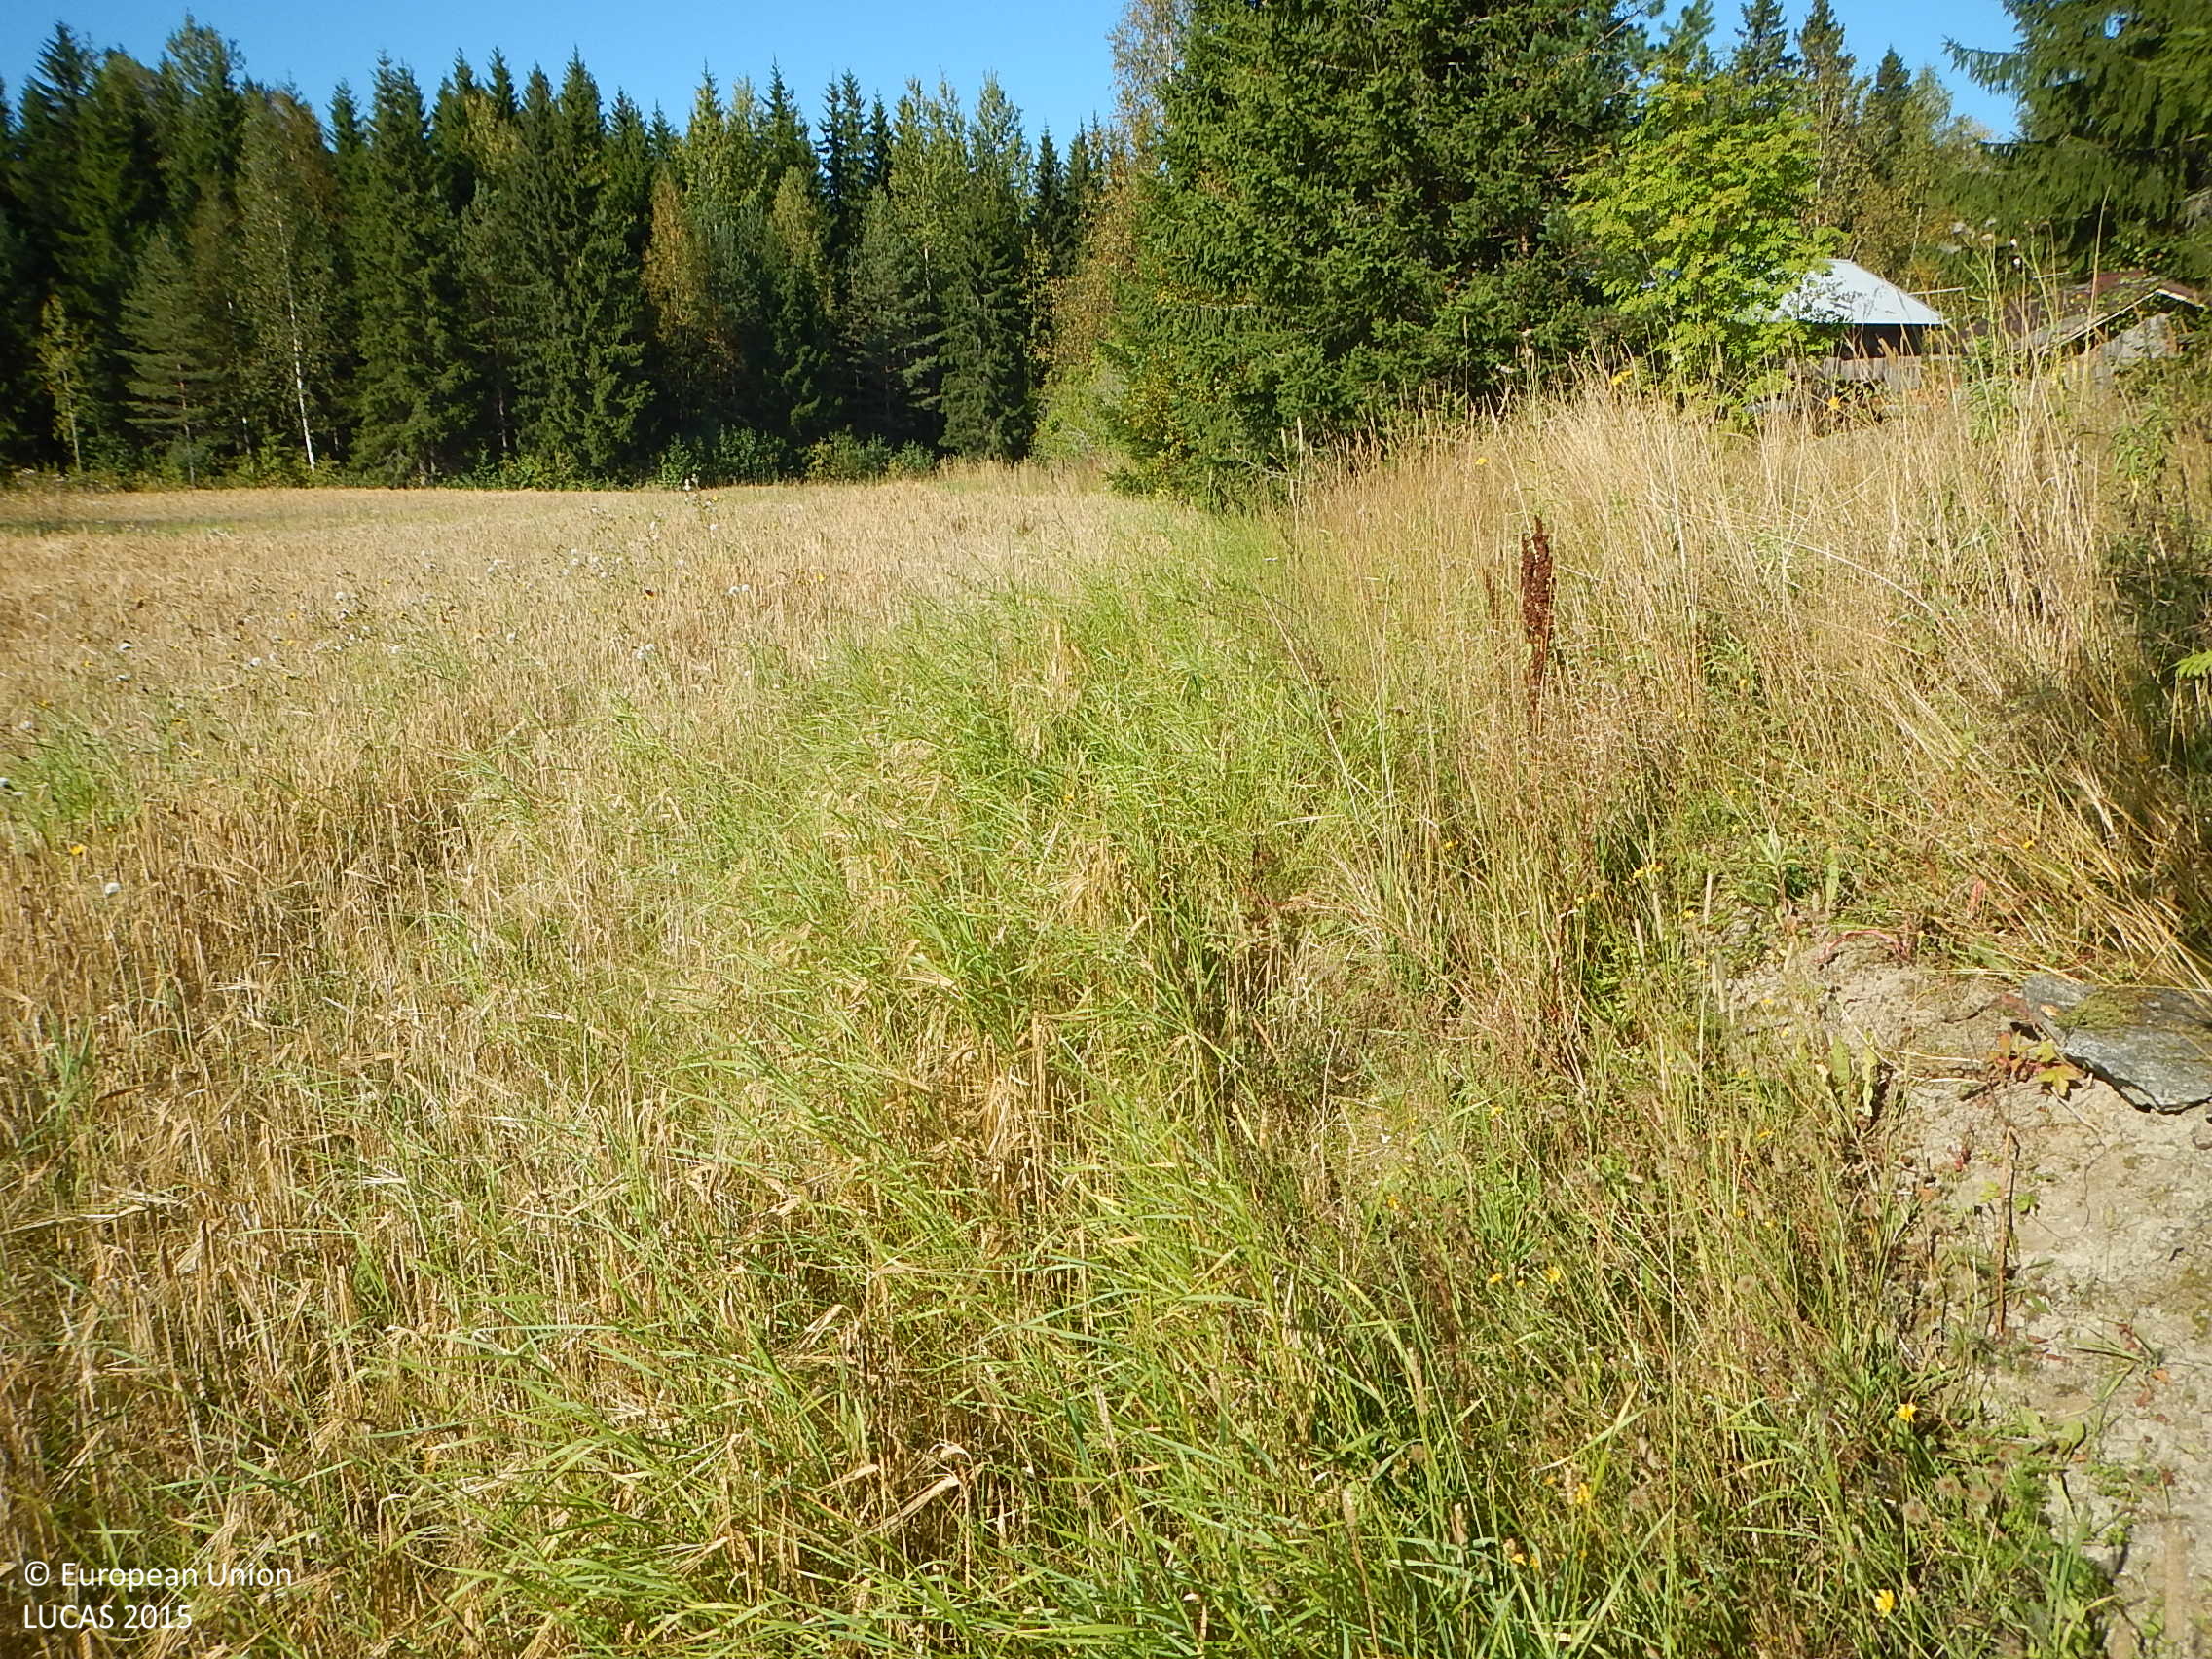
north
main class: Cropland
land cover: Barley
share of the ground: > 75 %
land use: Agriculture (excluding fallow land and kitchen gardens)
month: September
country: FI
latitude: 61.5921
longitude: 22.7473
